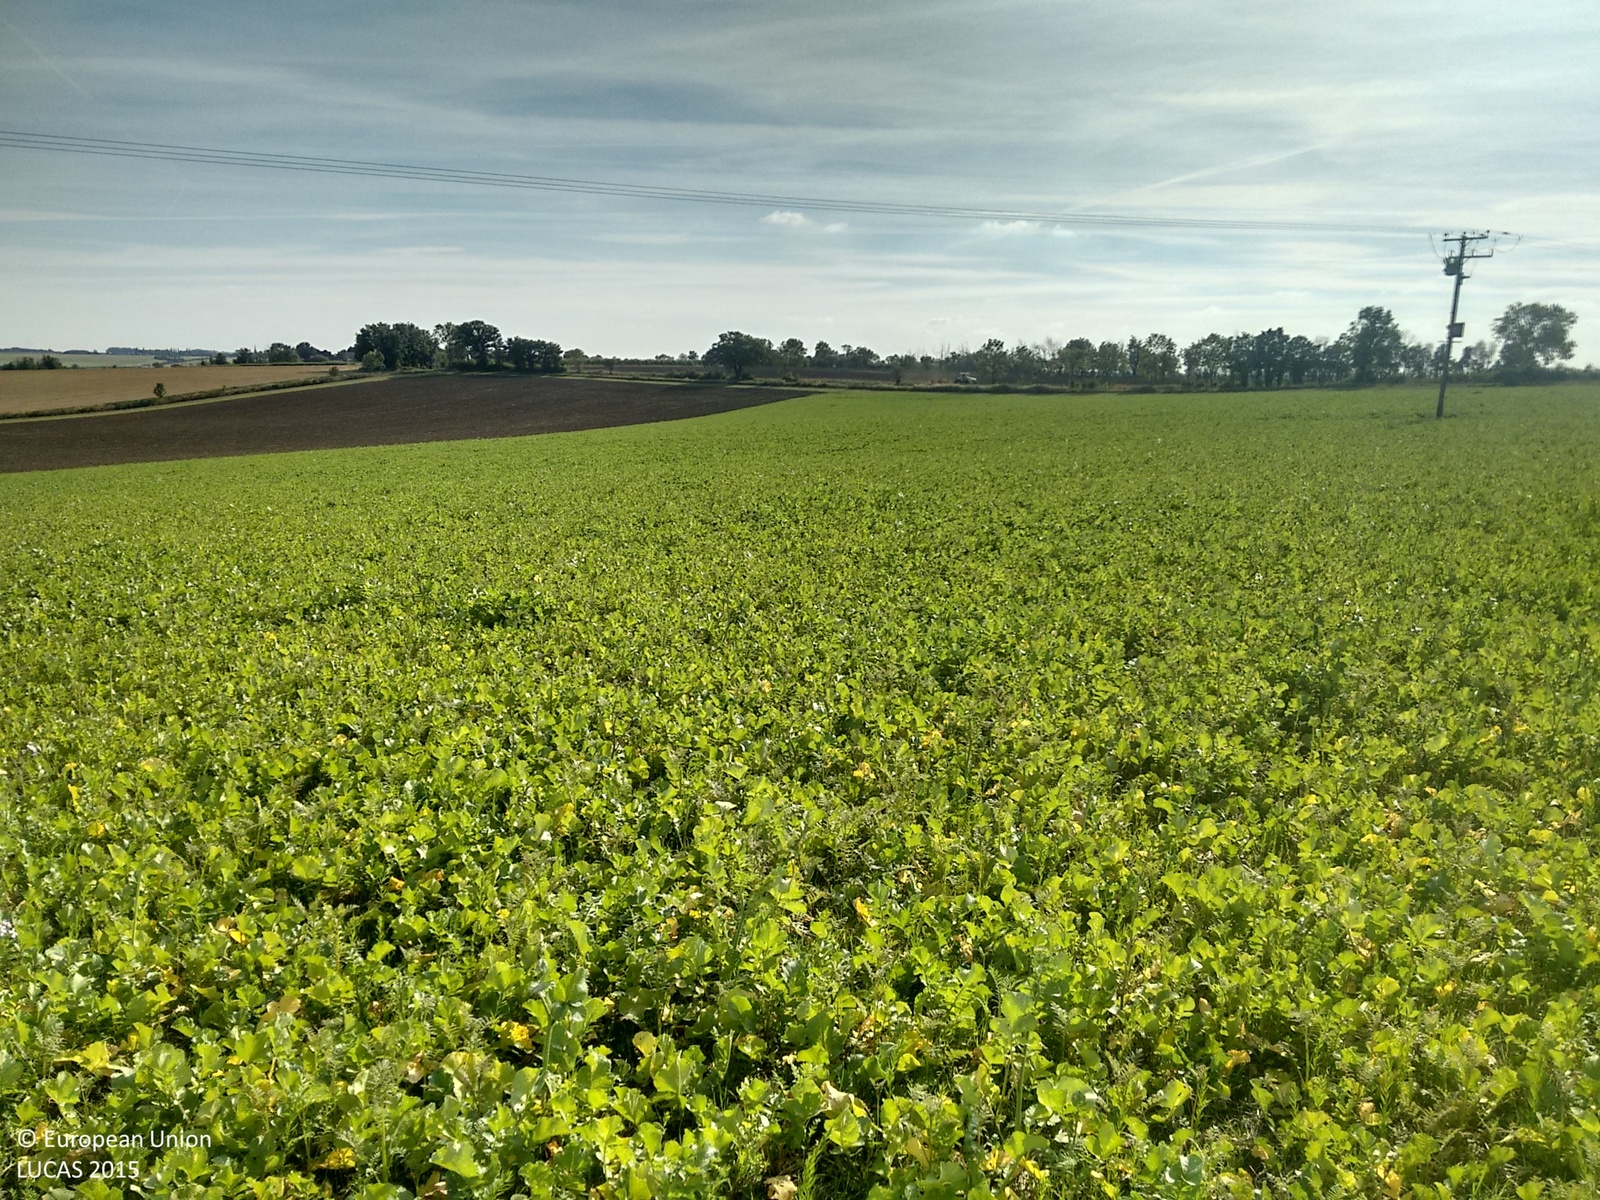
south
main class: Grassland
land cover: Spontaneously vegetated surfaces
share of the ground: > 75 %
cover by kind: herbaceous plants 100 %
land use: Fallow land
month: September
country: GB
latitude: 52.2820
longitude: -0.4004
